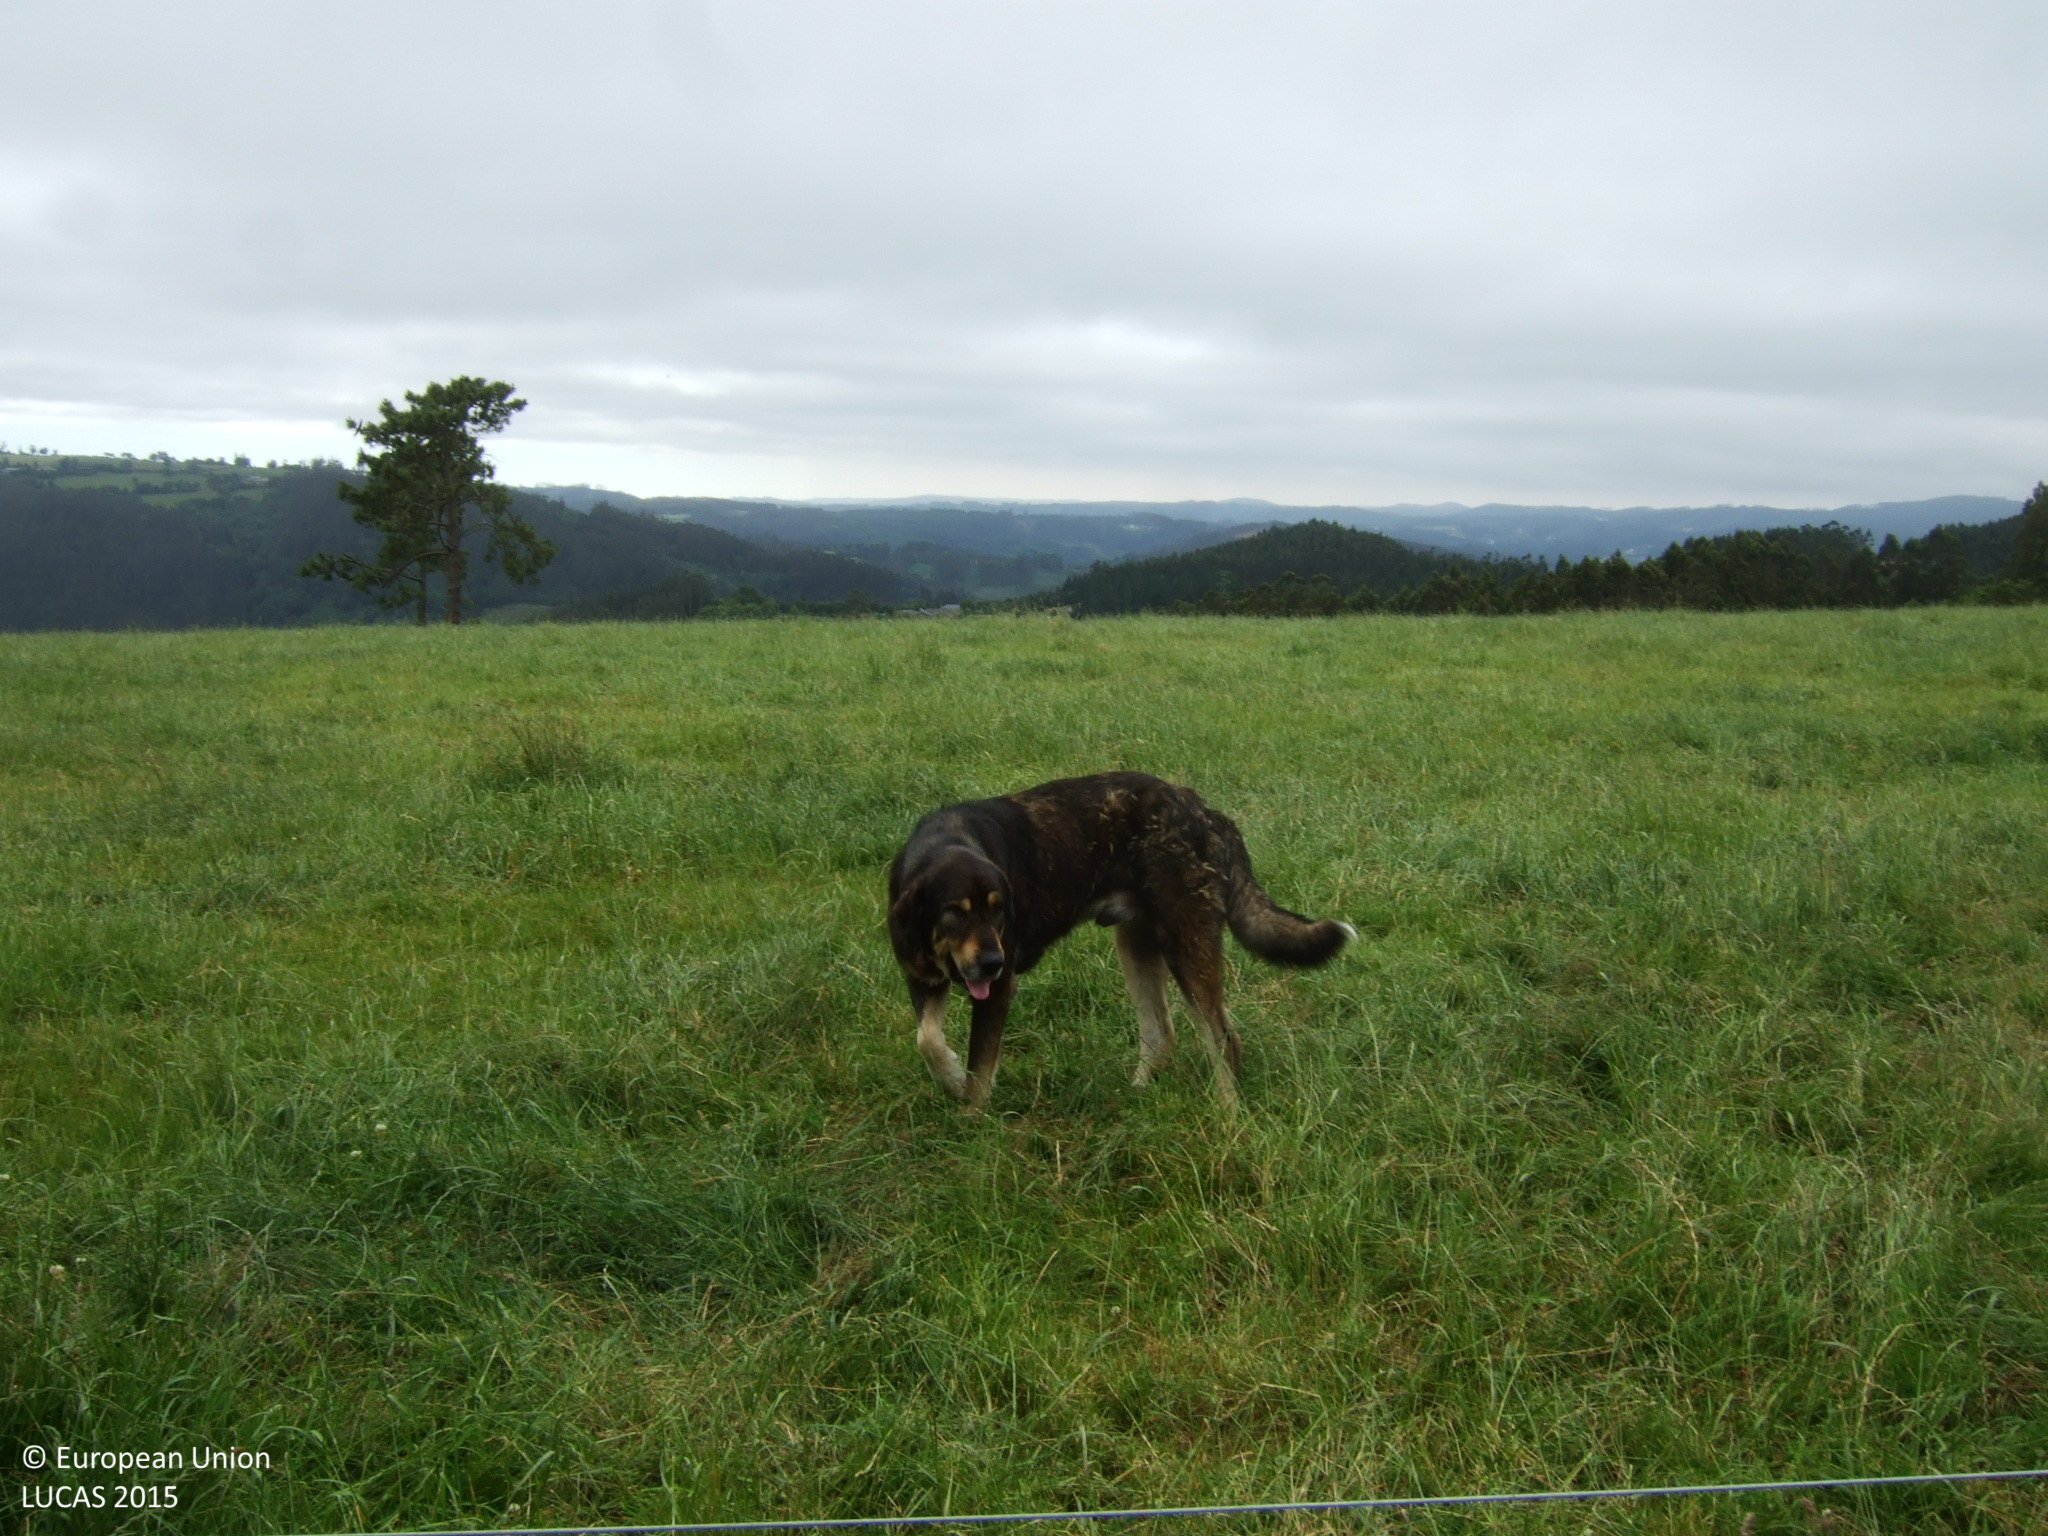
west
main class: Grassland
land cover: Grassland without tree/shrub cover
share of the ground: > 75 %
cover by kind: herbaceous plants 100 %
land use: Agriculture (excluding fallow land and kitchen gardens)
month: June
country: ES
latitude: 43.5997
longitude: -7.8445
